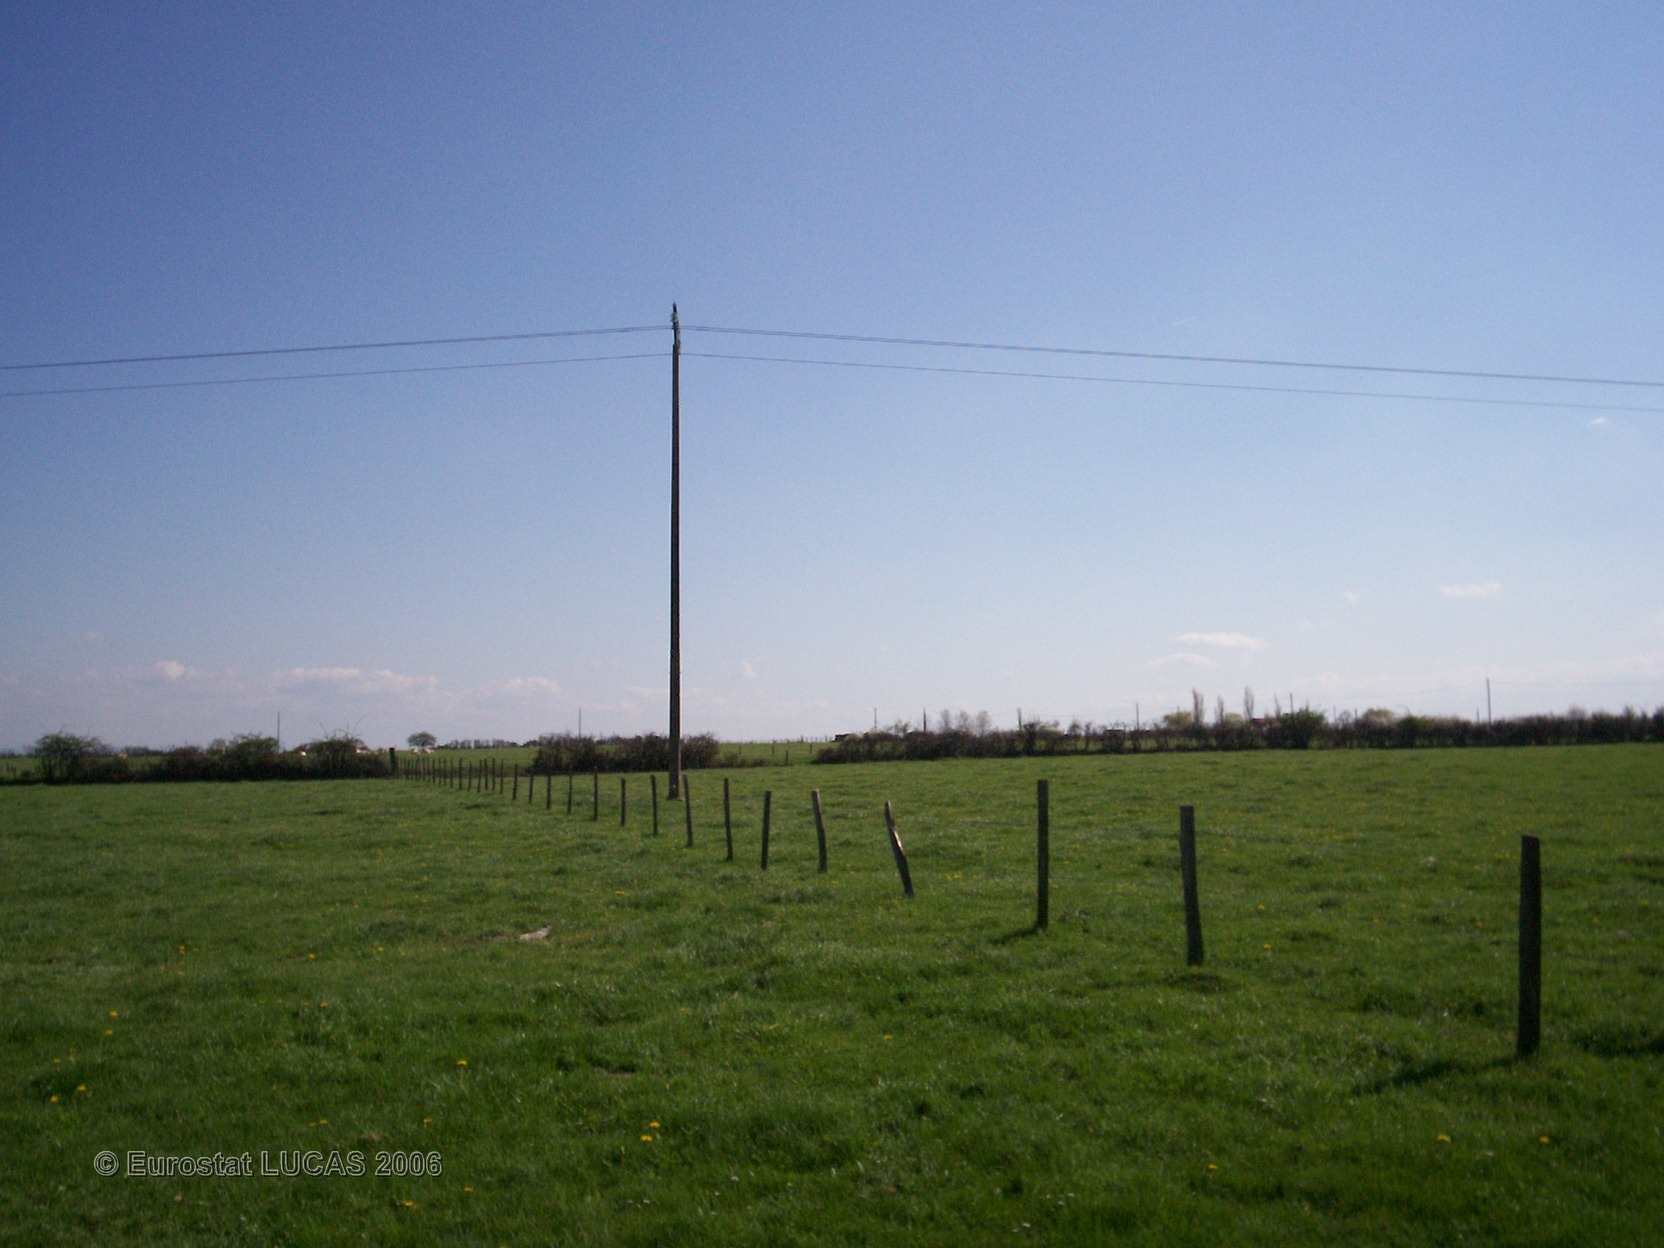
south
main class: Grassland
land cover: Grassland without tree/shrub cover
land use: Agriculture (excluding fallow land and kitchen gardens)
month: April
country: FR
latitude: 45.6335
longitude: 4.1919
